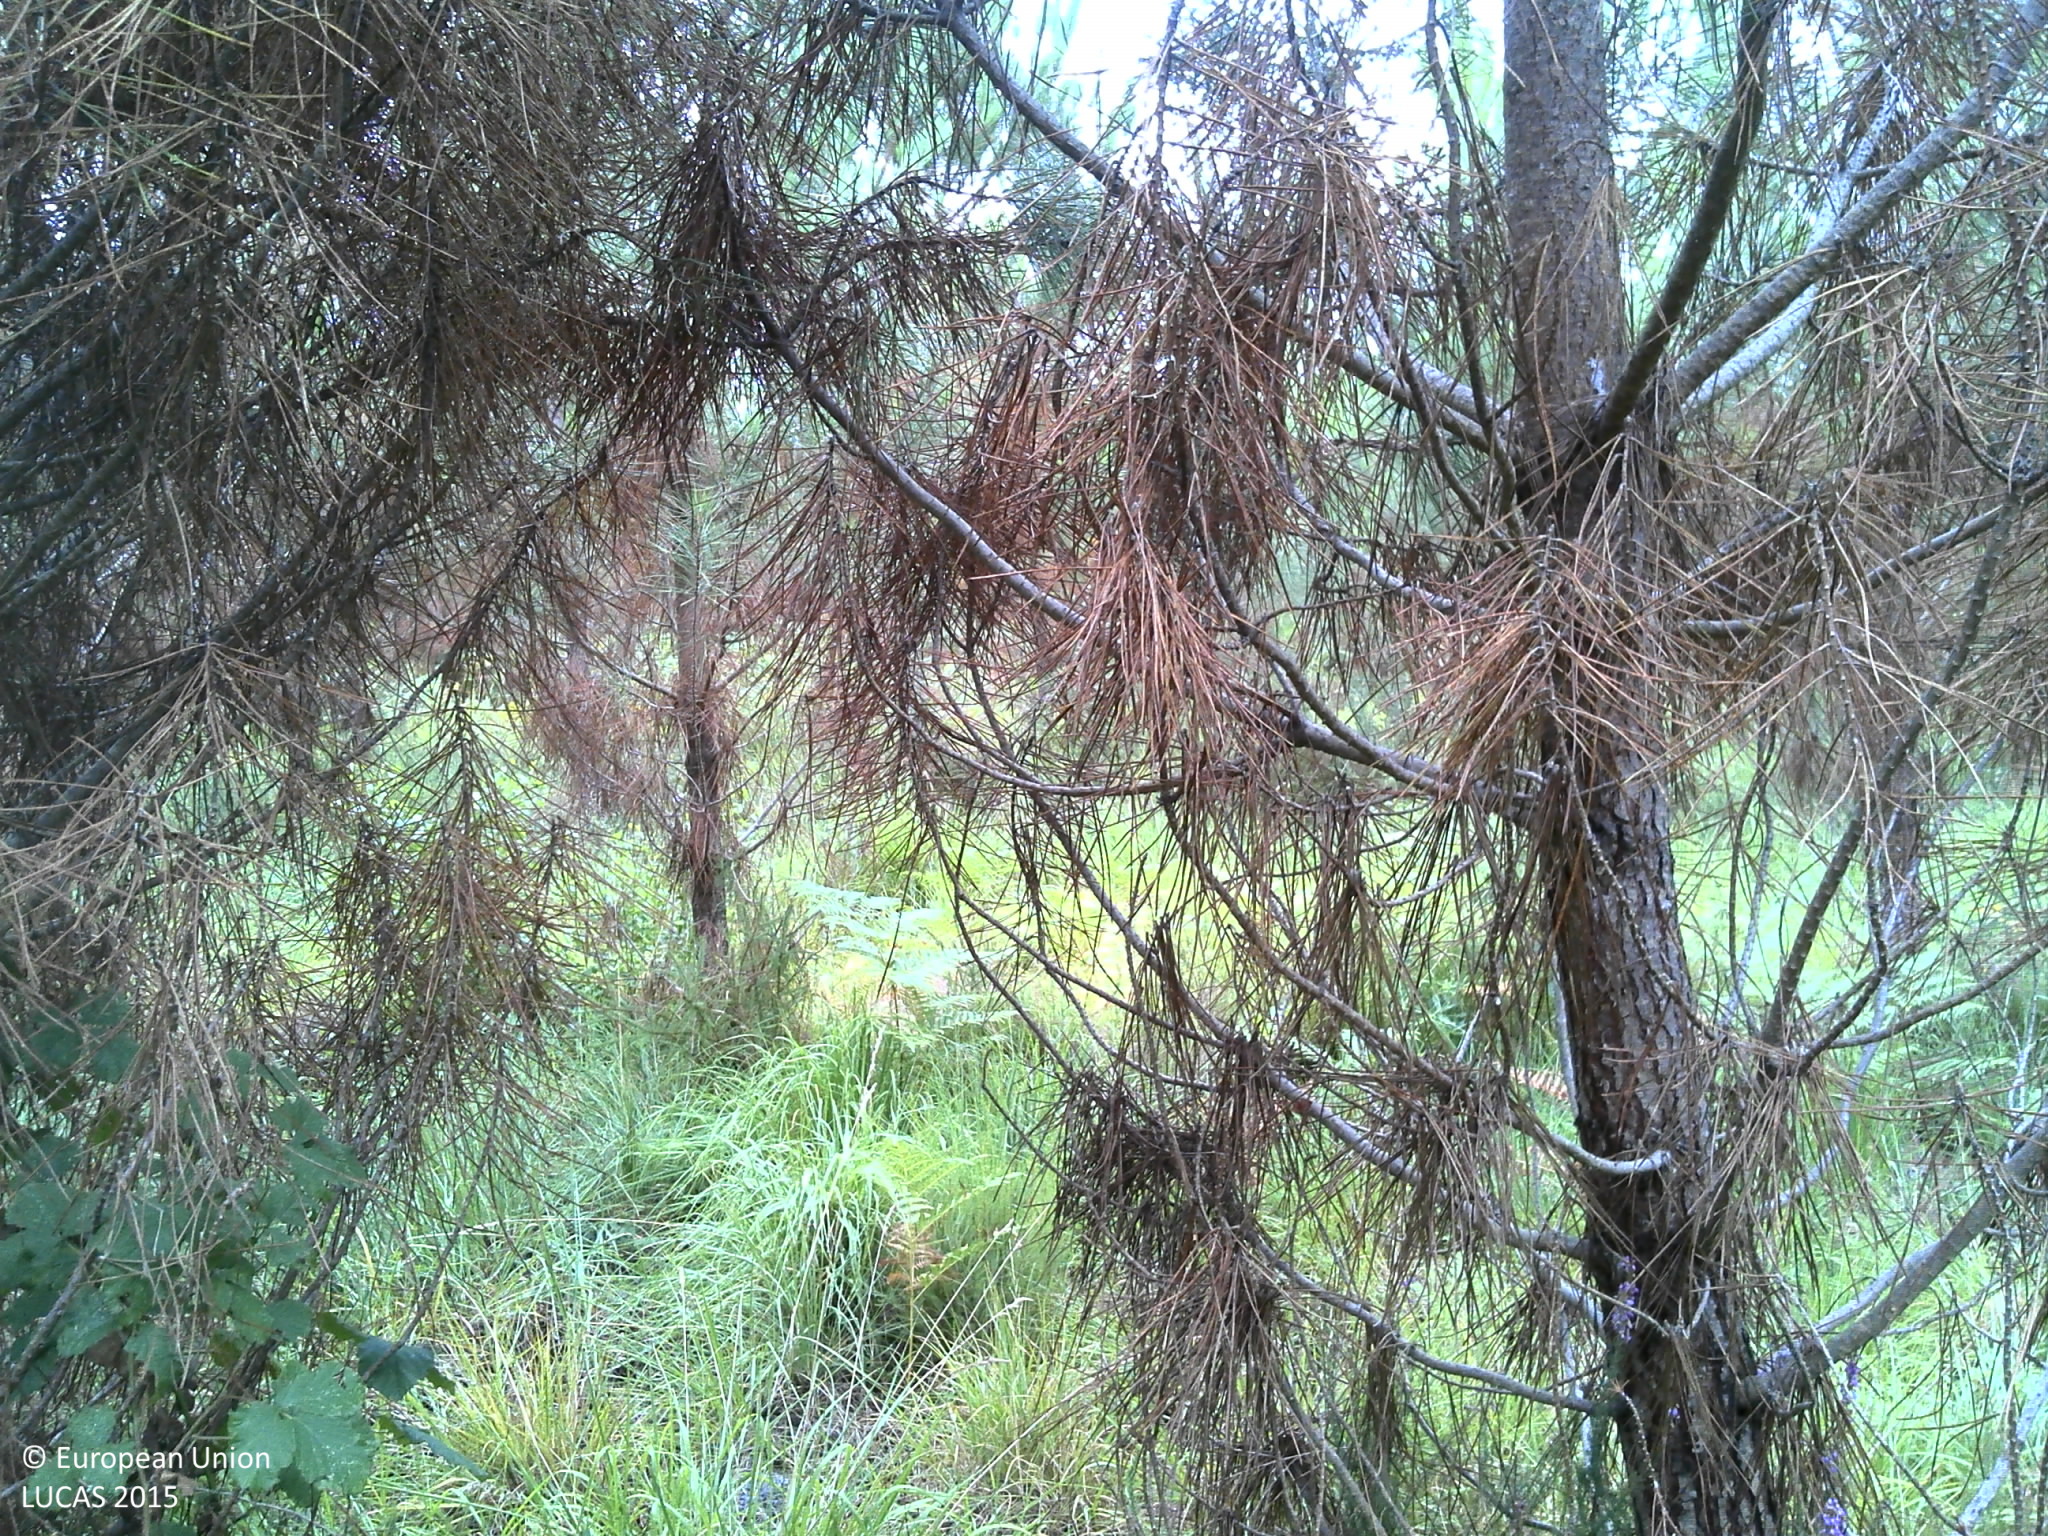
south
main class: Woodland
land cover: Pine dominated coniferous woodland
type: coniferous forest of the mediterranean region
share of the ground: 50 - 75 %
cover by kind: coniferous forest trees 60 %, shrubs 30 %, herbaceous plants 5 %, lichens and mosses 5 %
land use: Forestry
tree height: > 5 m
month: August
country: FR
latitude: 44.5503
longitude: -0.9593
